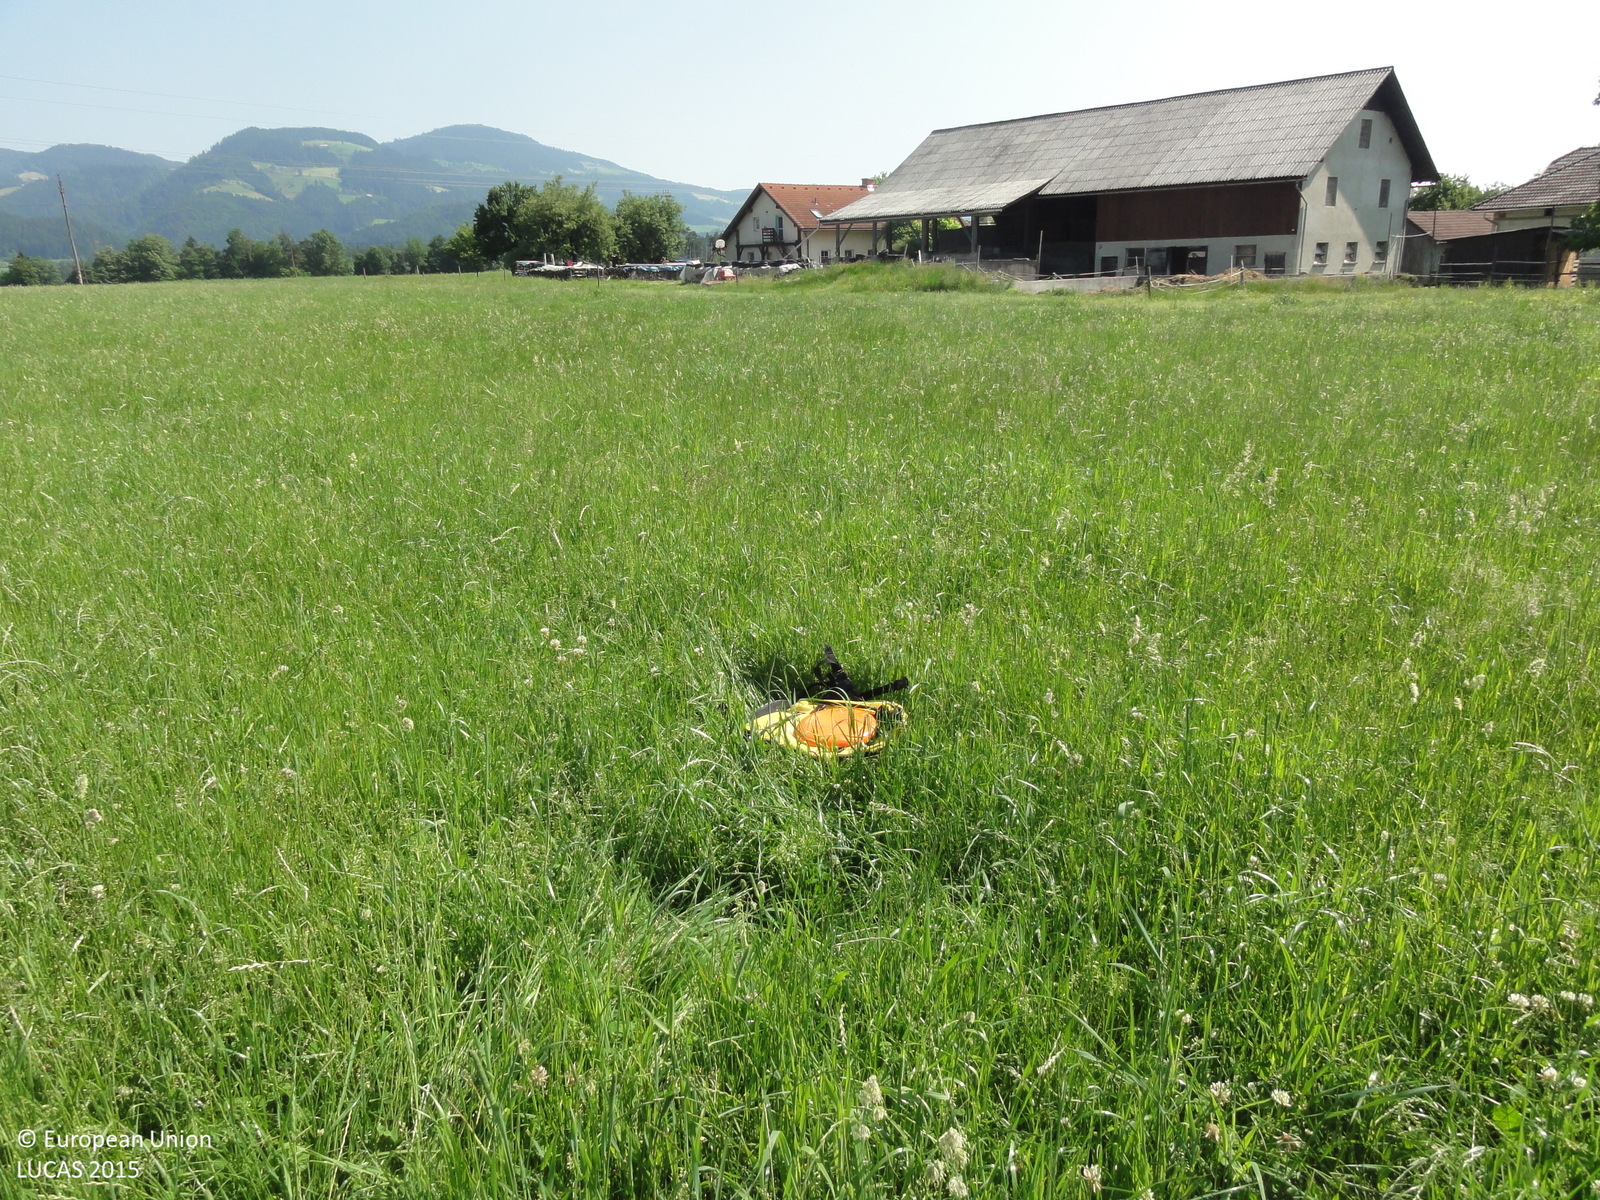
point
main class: Grassland
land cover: Grassland without tree/shrub cover
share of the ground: > 75 %
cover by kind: herbaceous plants 100 %
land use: Agriculture (excluding fallow land and kitchen gardens)
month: June
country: SI
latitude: 46.5892
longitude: 15.1275
